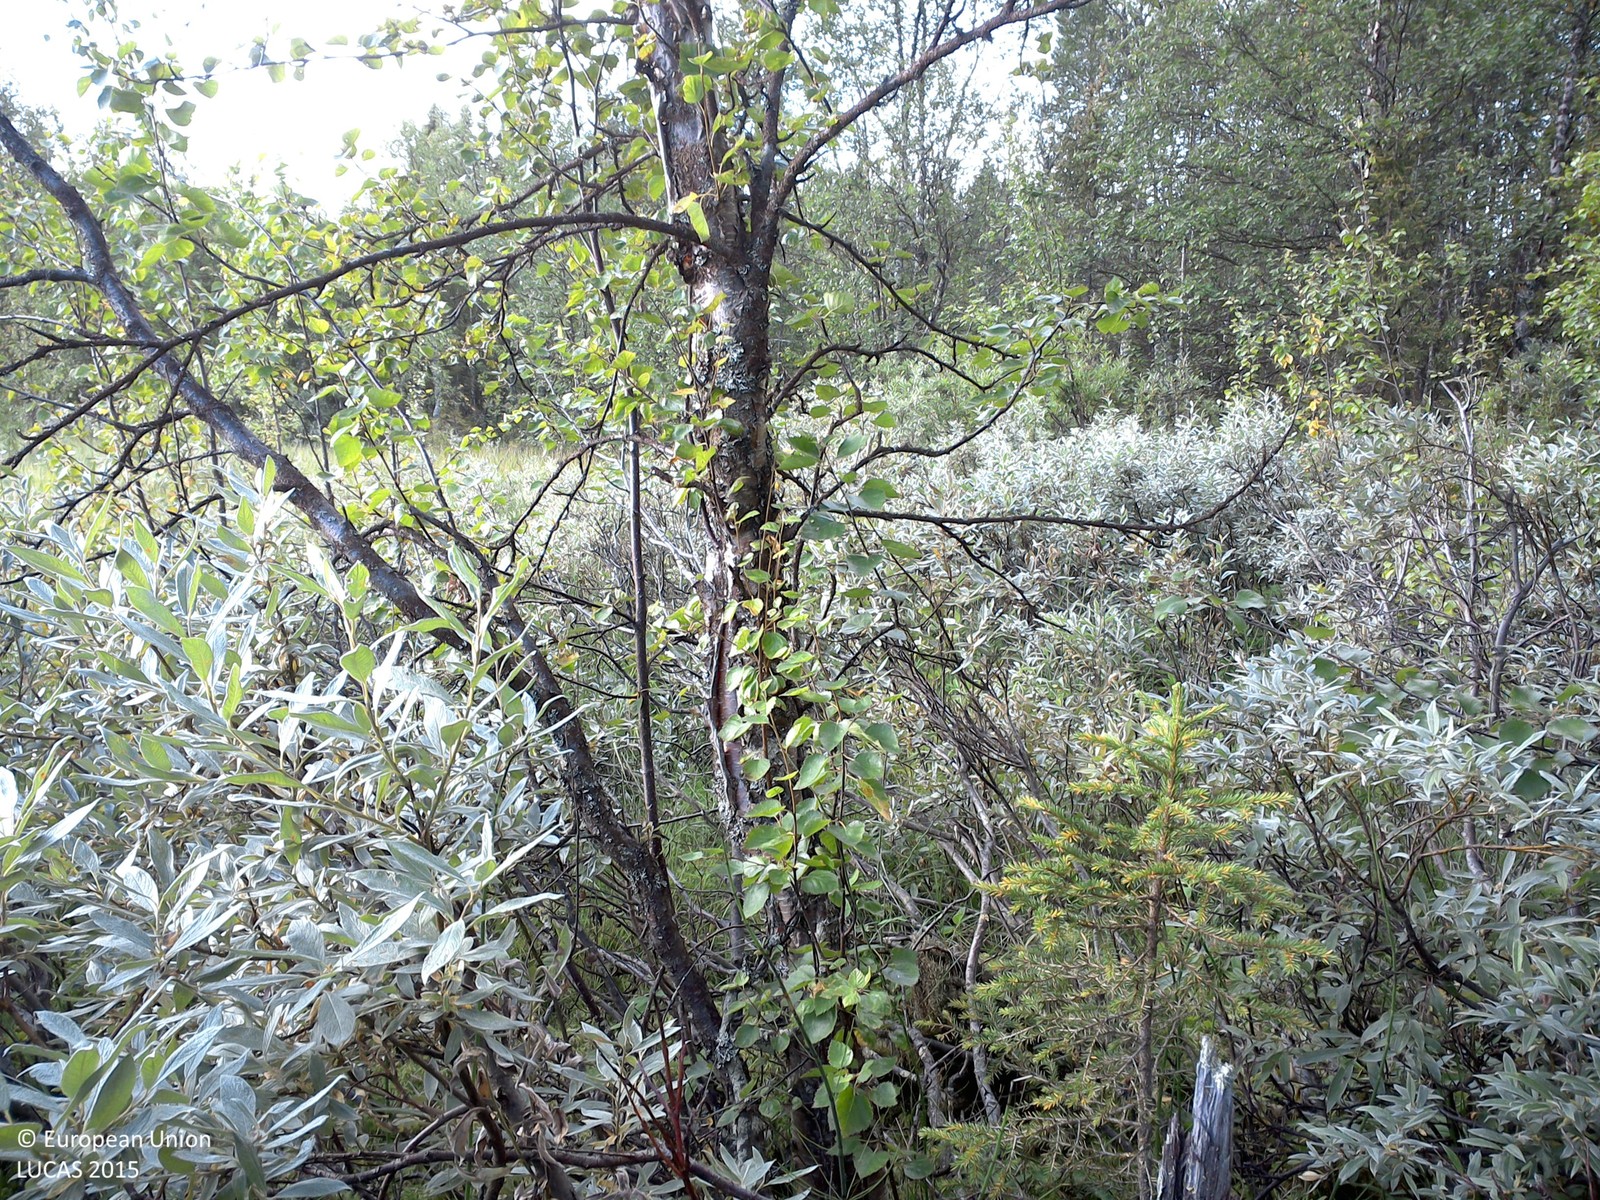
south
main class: Woodland
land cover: Broadleaved woodland
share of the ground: 50 - 75 %
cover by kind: broadleaved forest trees 55 %, shrubs 40 %, herbaceous plants 5 %
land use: Semi-natural and natural areas not in use
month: August
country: SE
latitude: 67.3837
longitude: 21.8144
